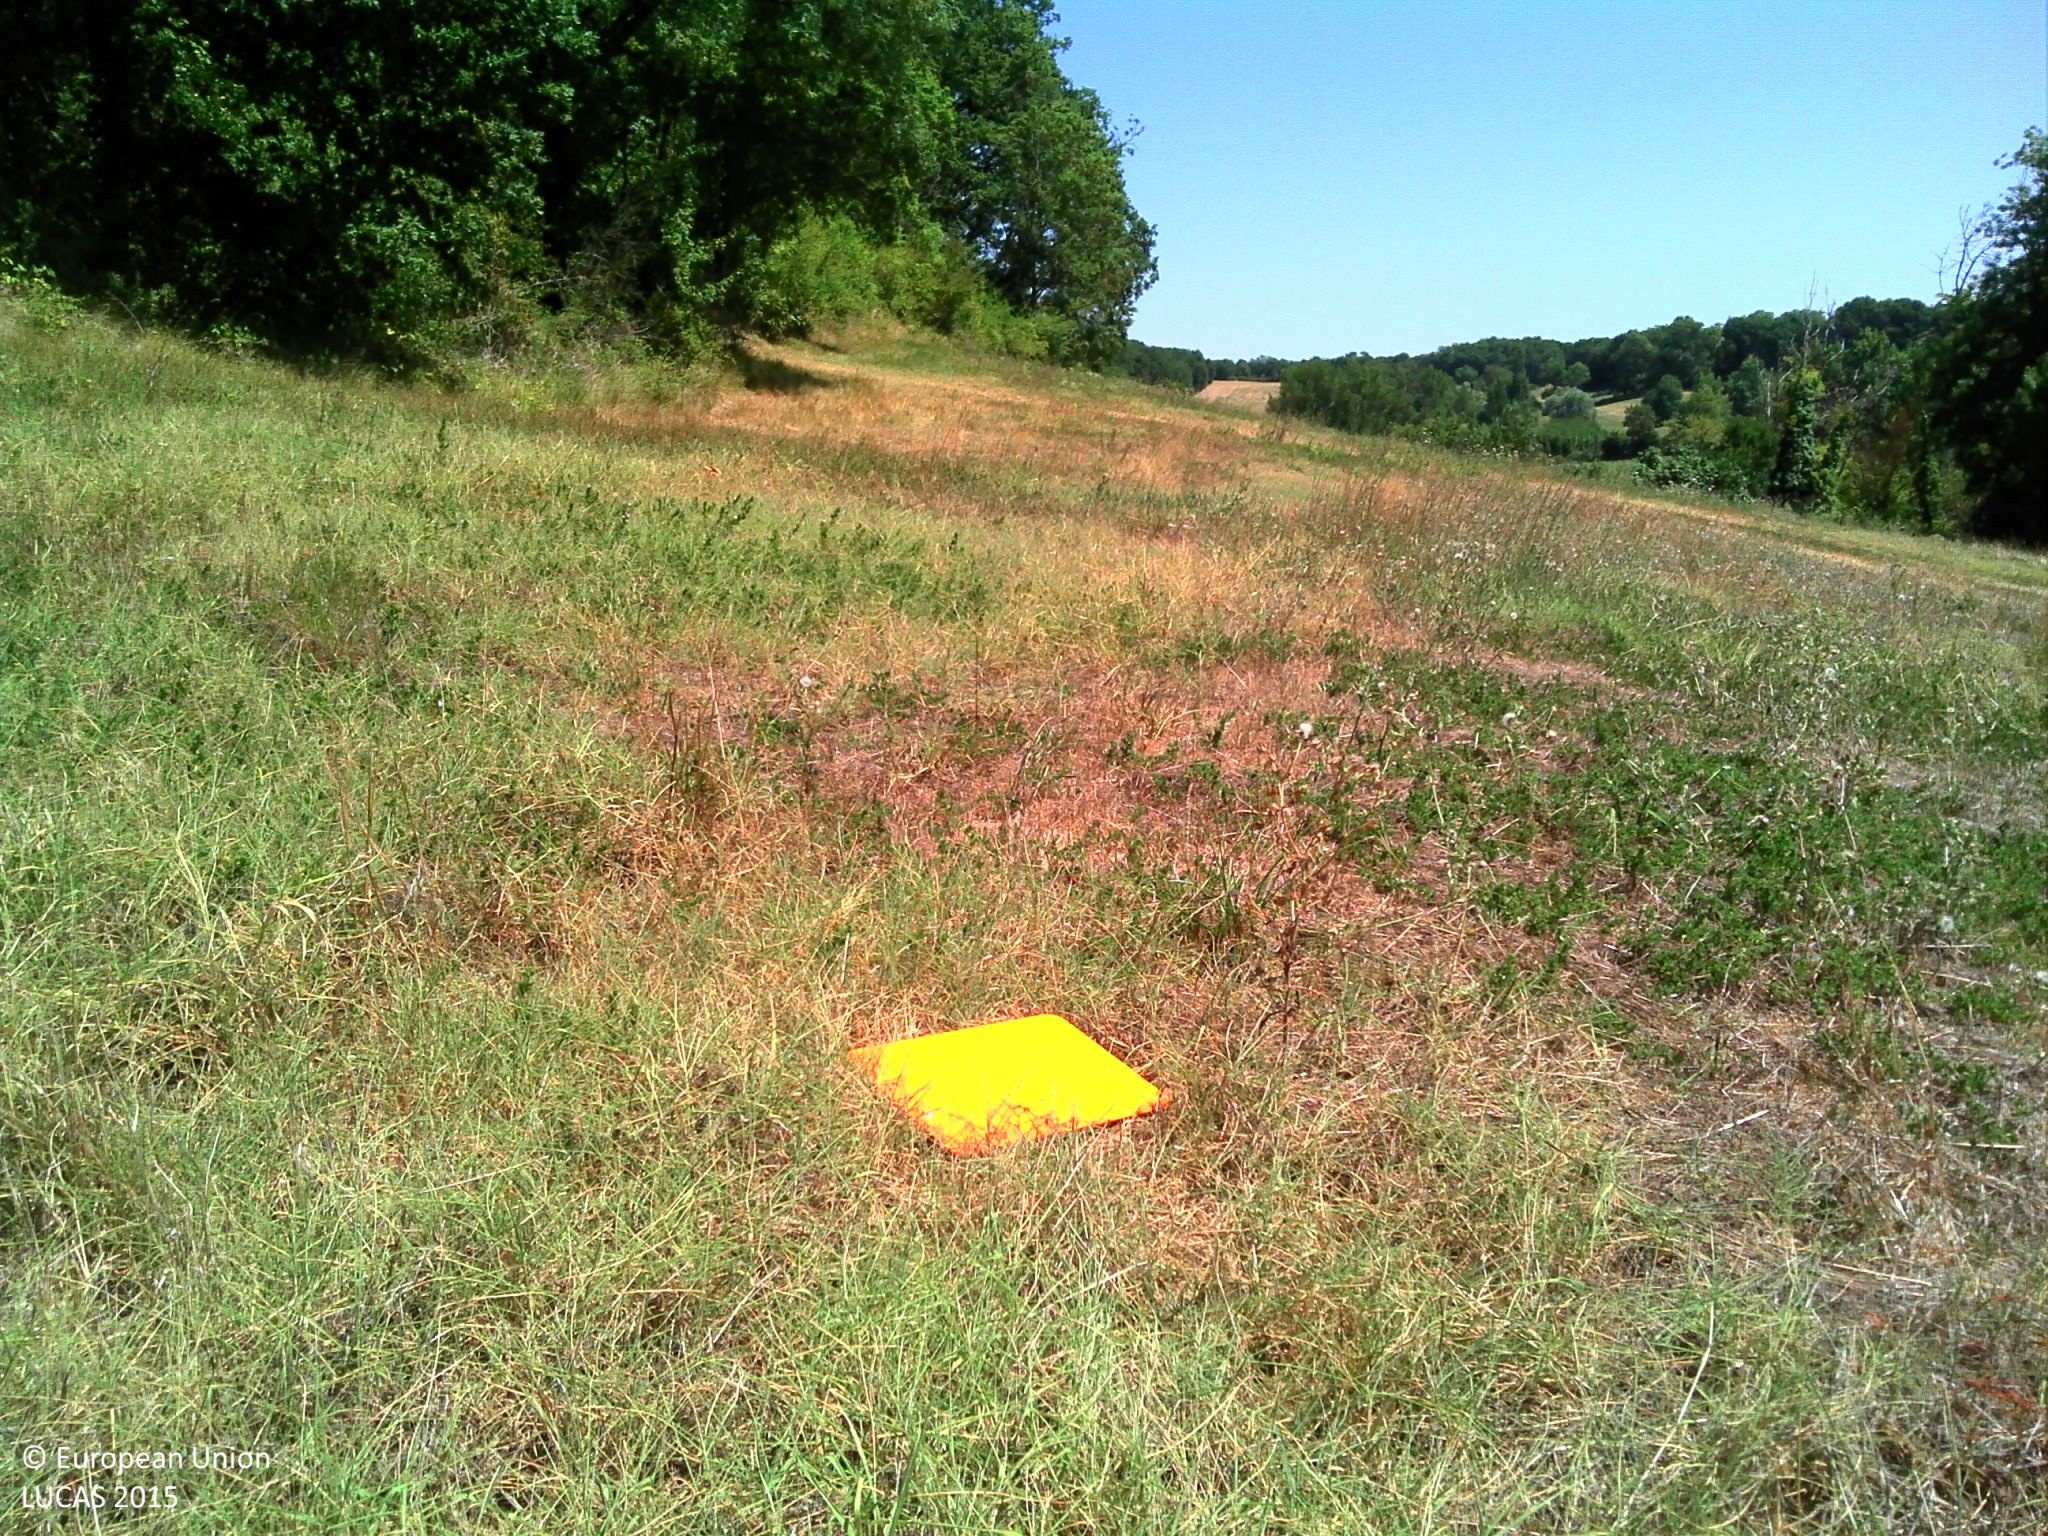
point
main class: Grassland
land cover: Grassland without tree/shrub cover
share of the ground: > 75 %
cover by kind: herbaceous plants 100 %
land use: Agriculture (excluding fallow land and kitchen gardens)
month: July
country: FR
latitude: 44.6152
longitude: 0.6293
